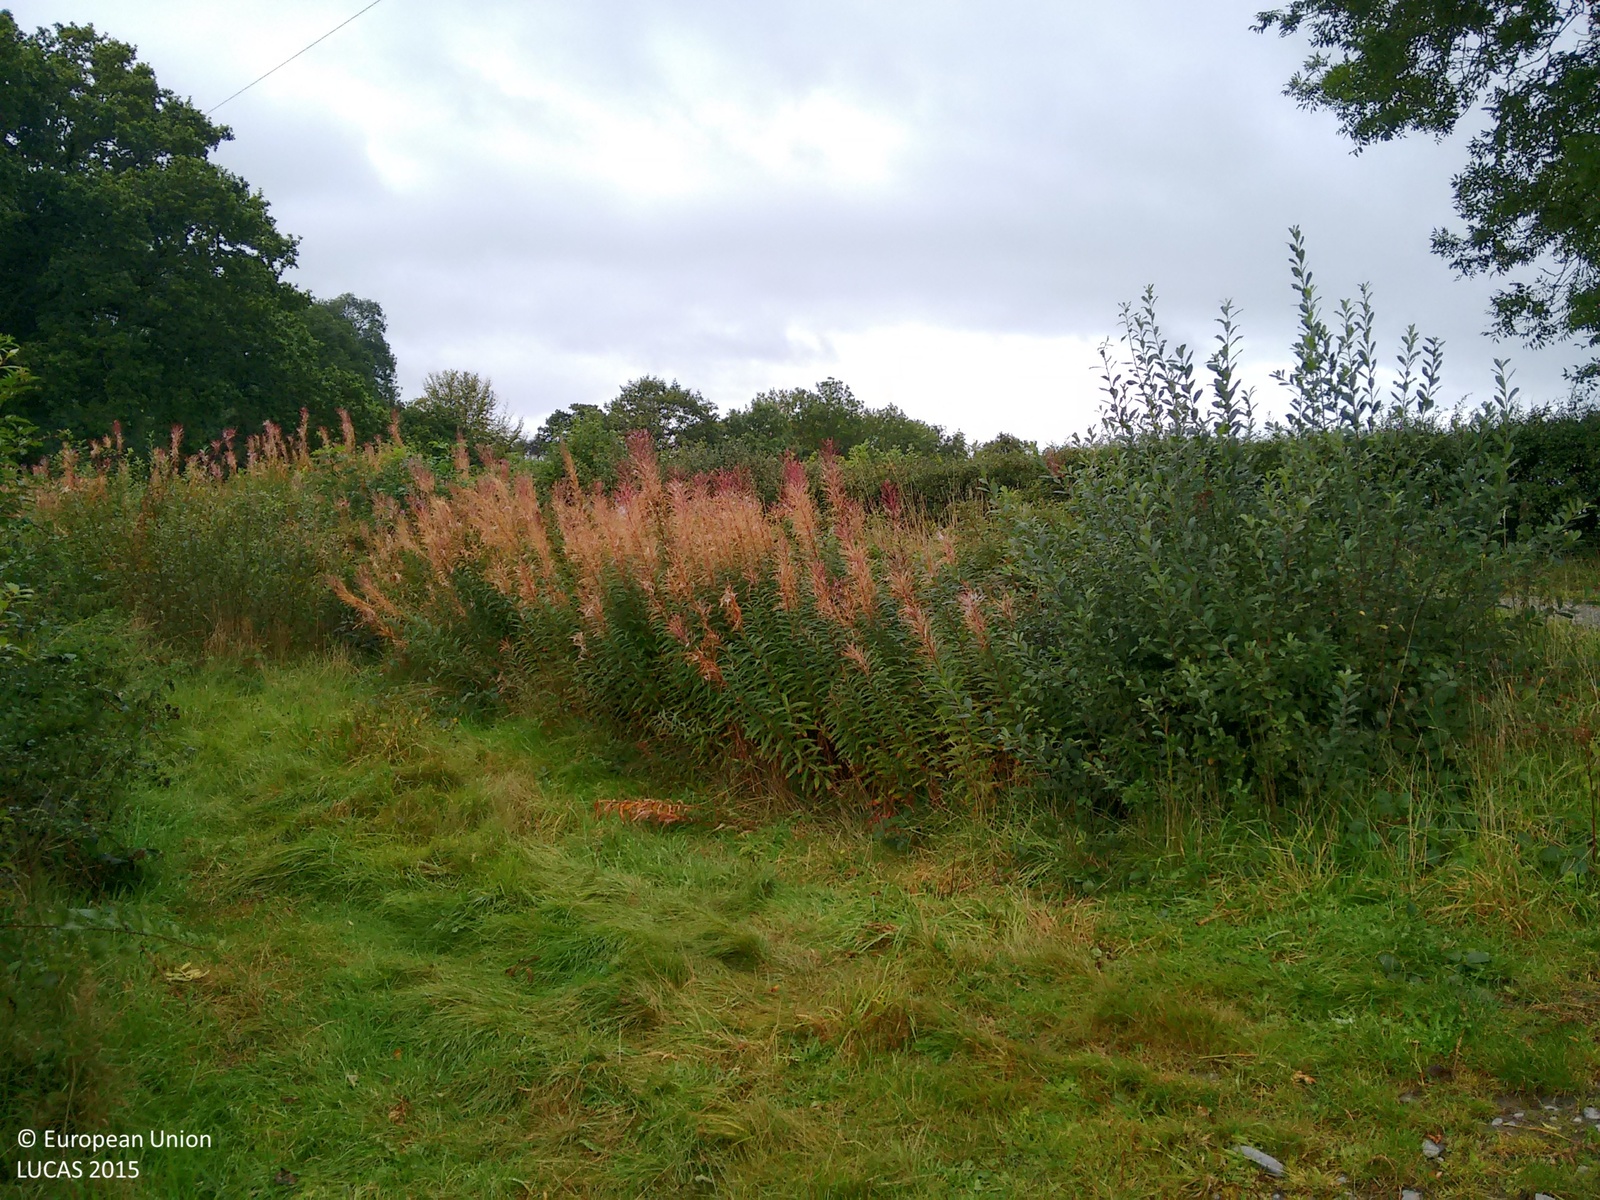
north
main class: Grassland
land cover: Grassland without tree/shrub cover
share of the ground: > 75 %
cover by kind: herbaceous plants 100 %
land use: Agriculture (excluding fallow land and kitchen gardens)
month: September
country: GB
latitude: 51.9836
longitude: -3.8214
